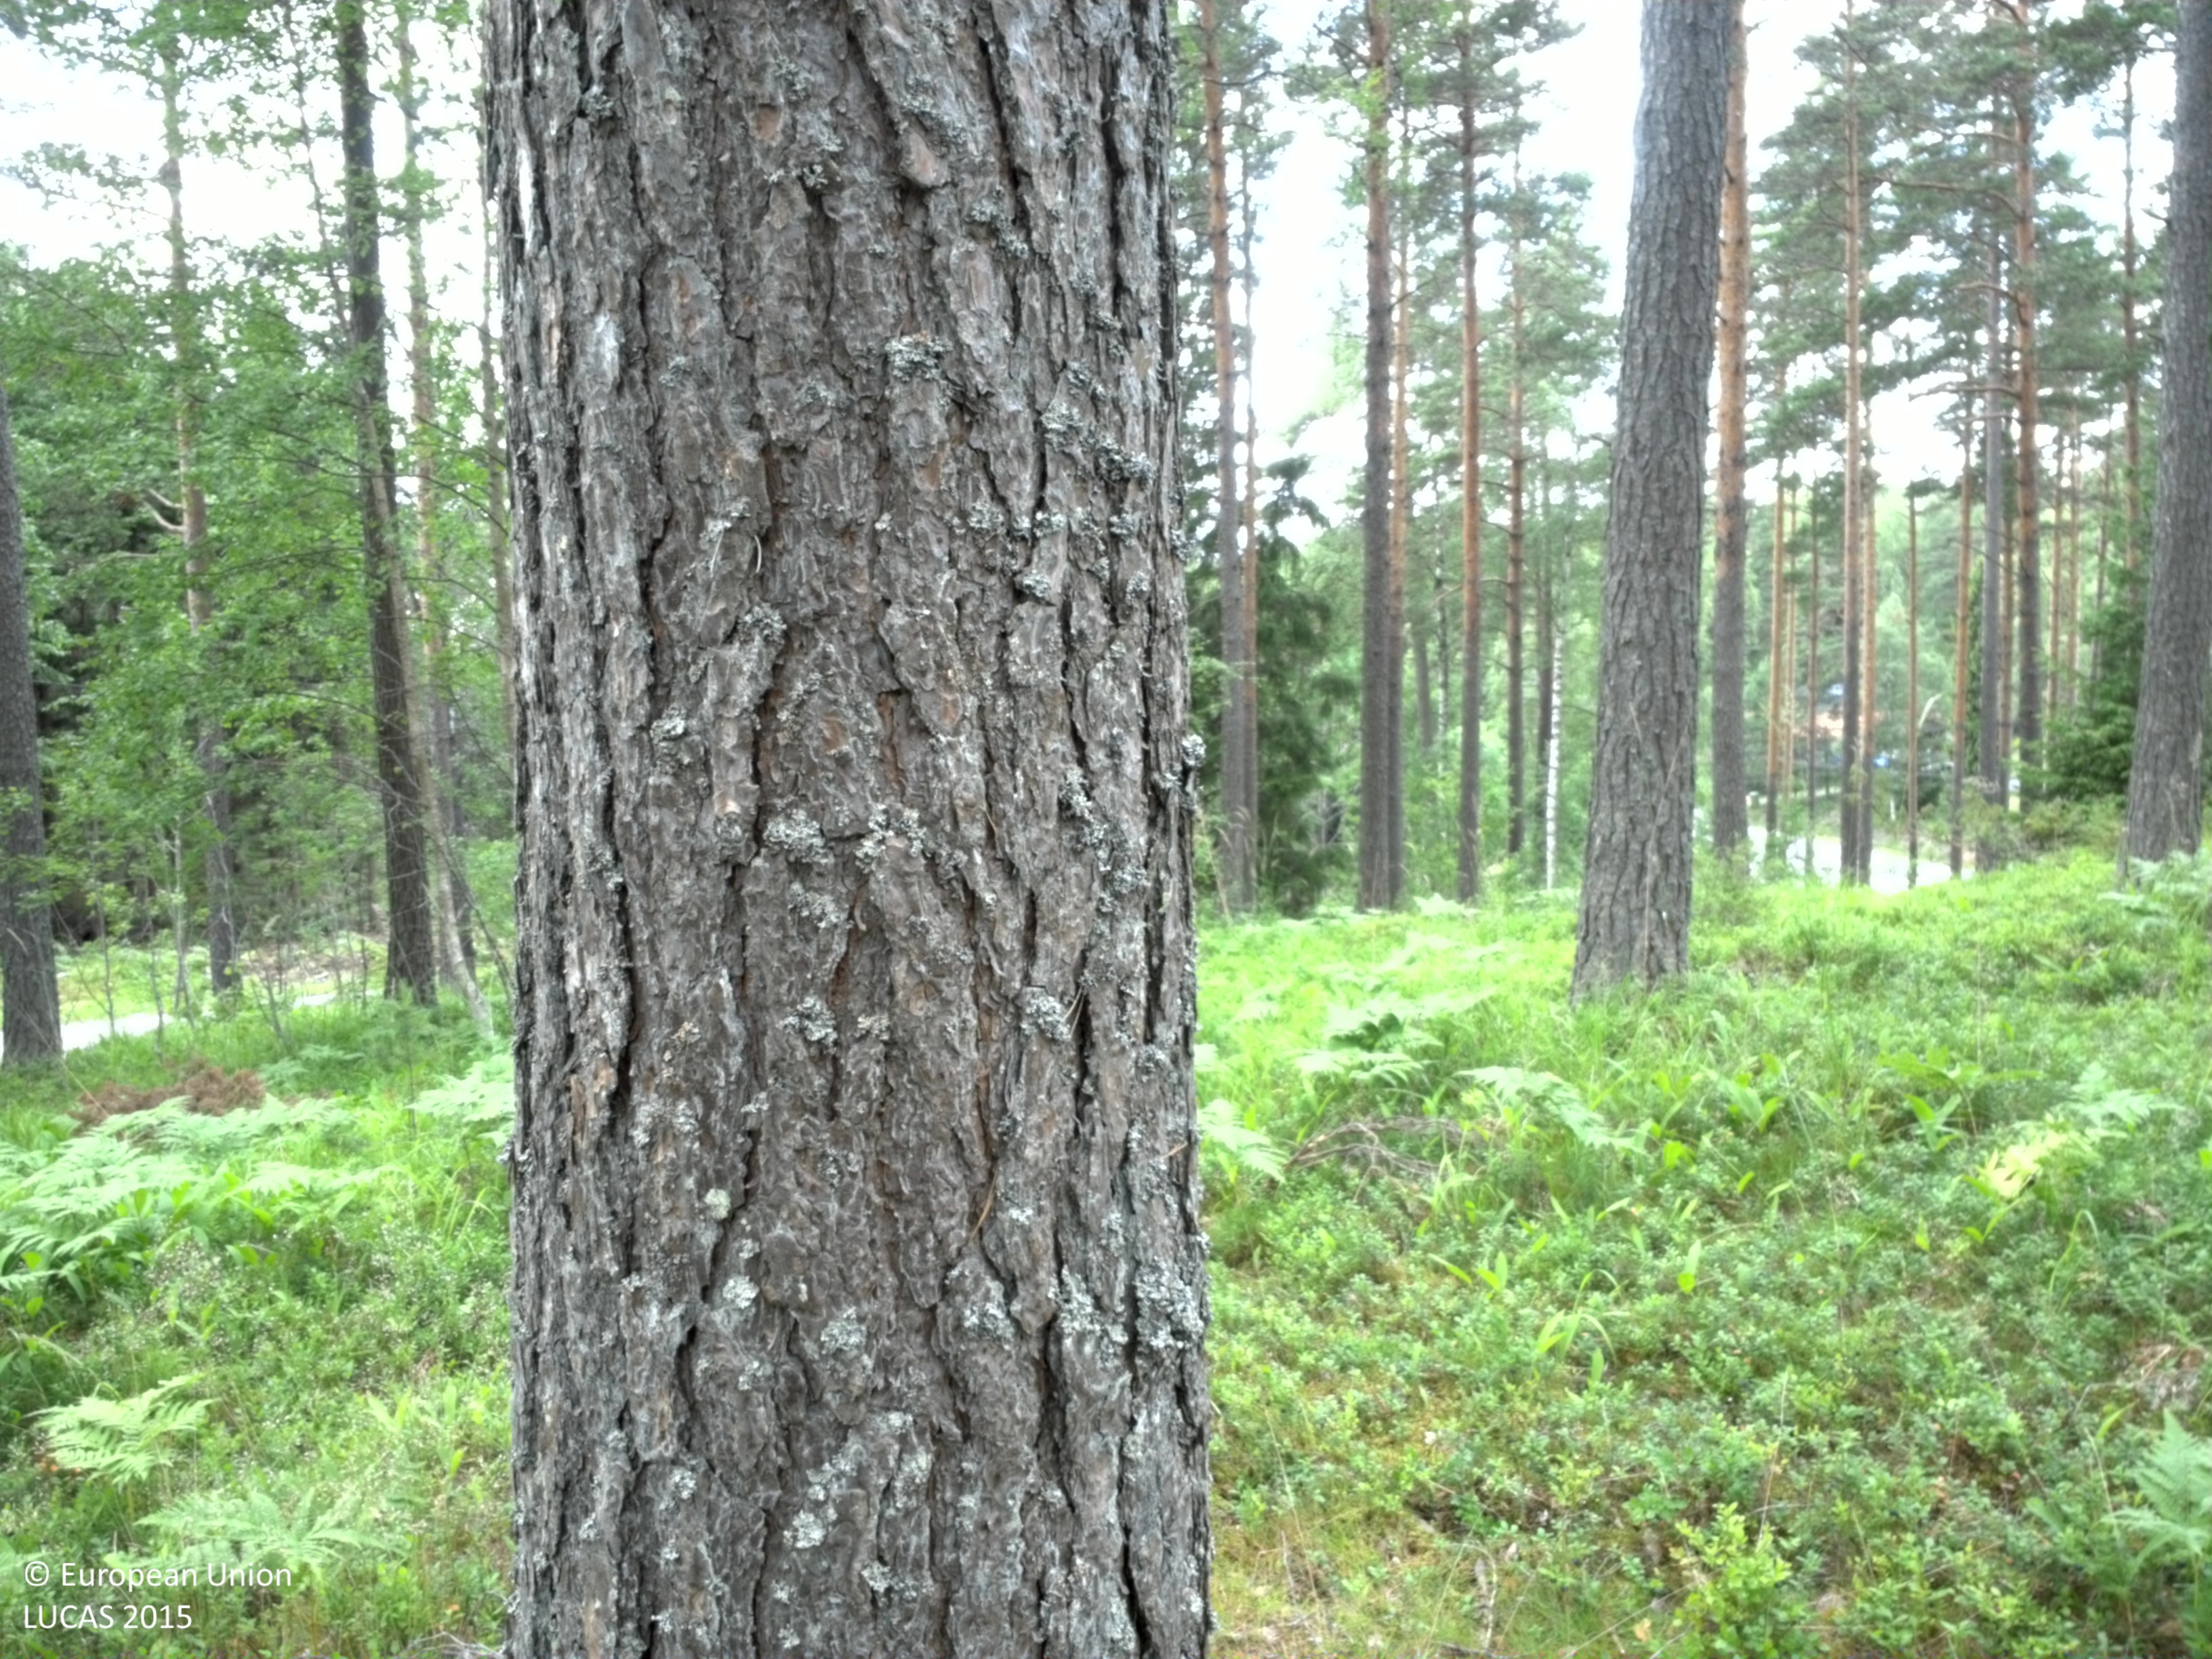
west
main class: Woodland
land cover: Pine dominated coniferous woodland
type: boreal forest
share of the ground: > 75 %
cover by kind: coniferous forest trees 70 %, herbaceous plants 20 %, broadleaved forest trees 10 %
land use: Forestry
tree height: > 5 m
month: July
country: SE
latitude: 59.5894
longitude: 18.3408
